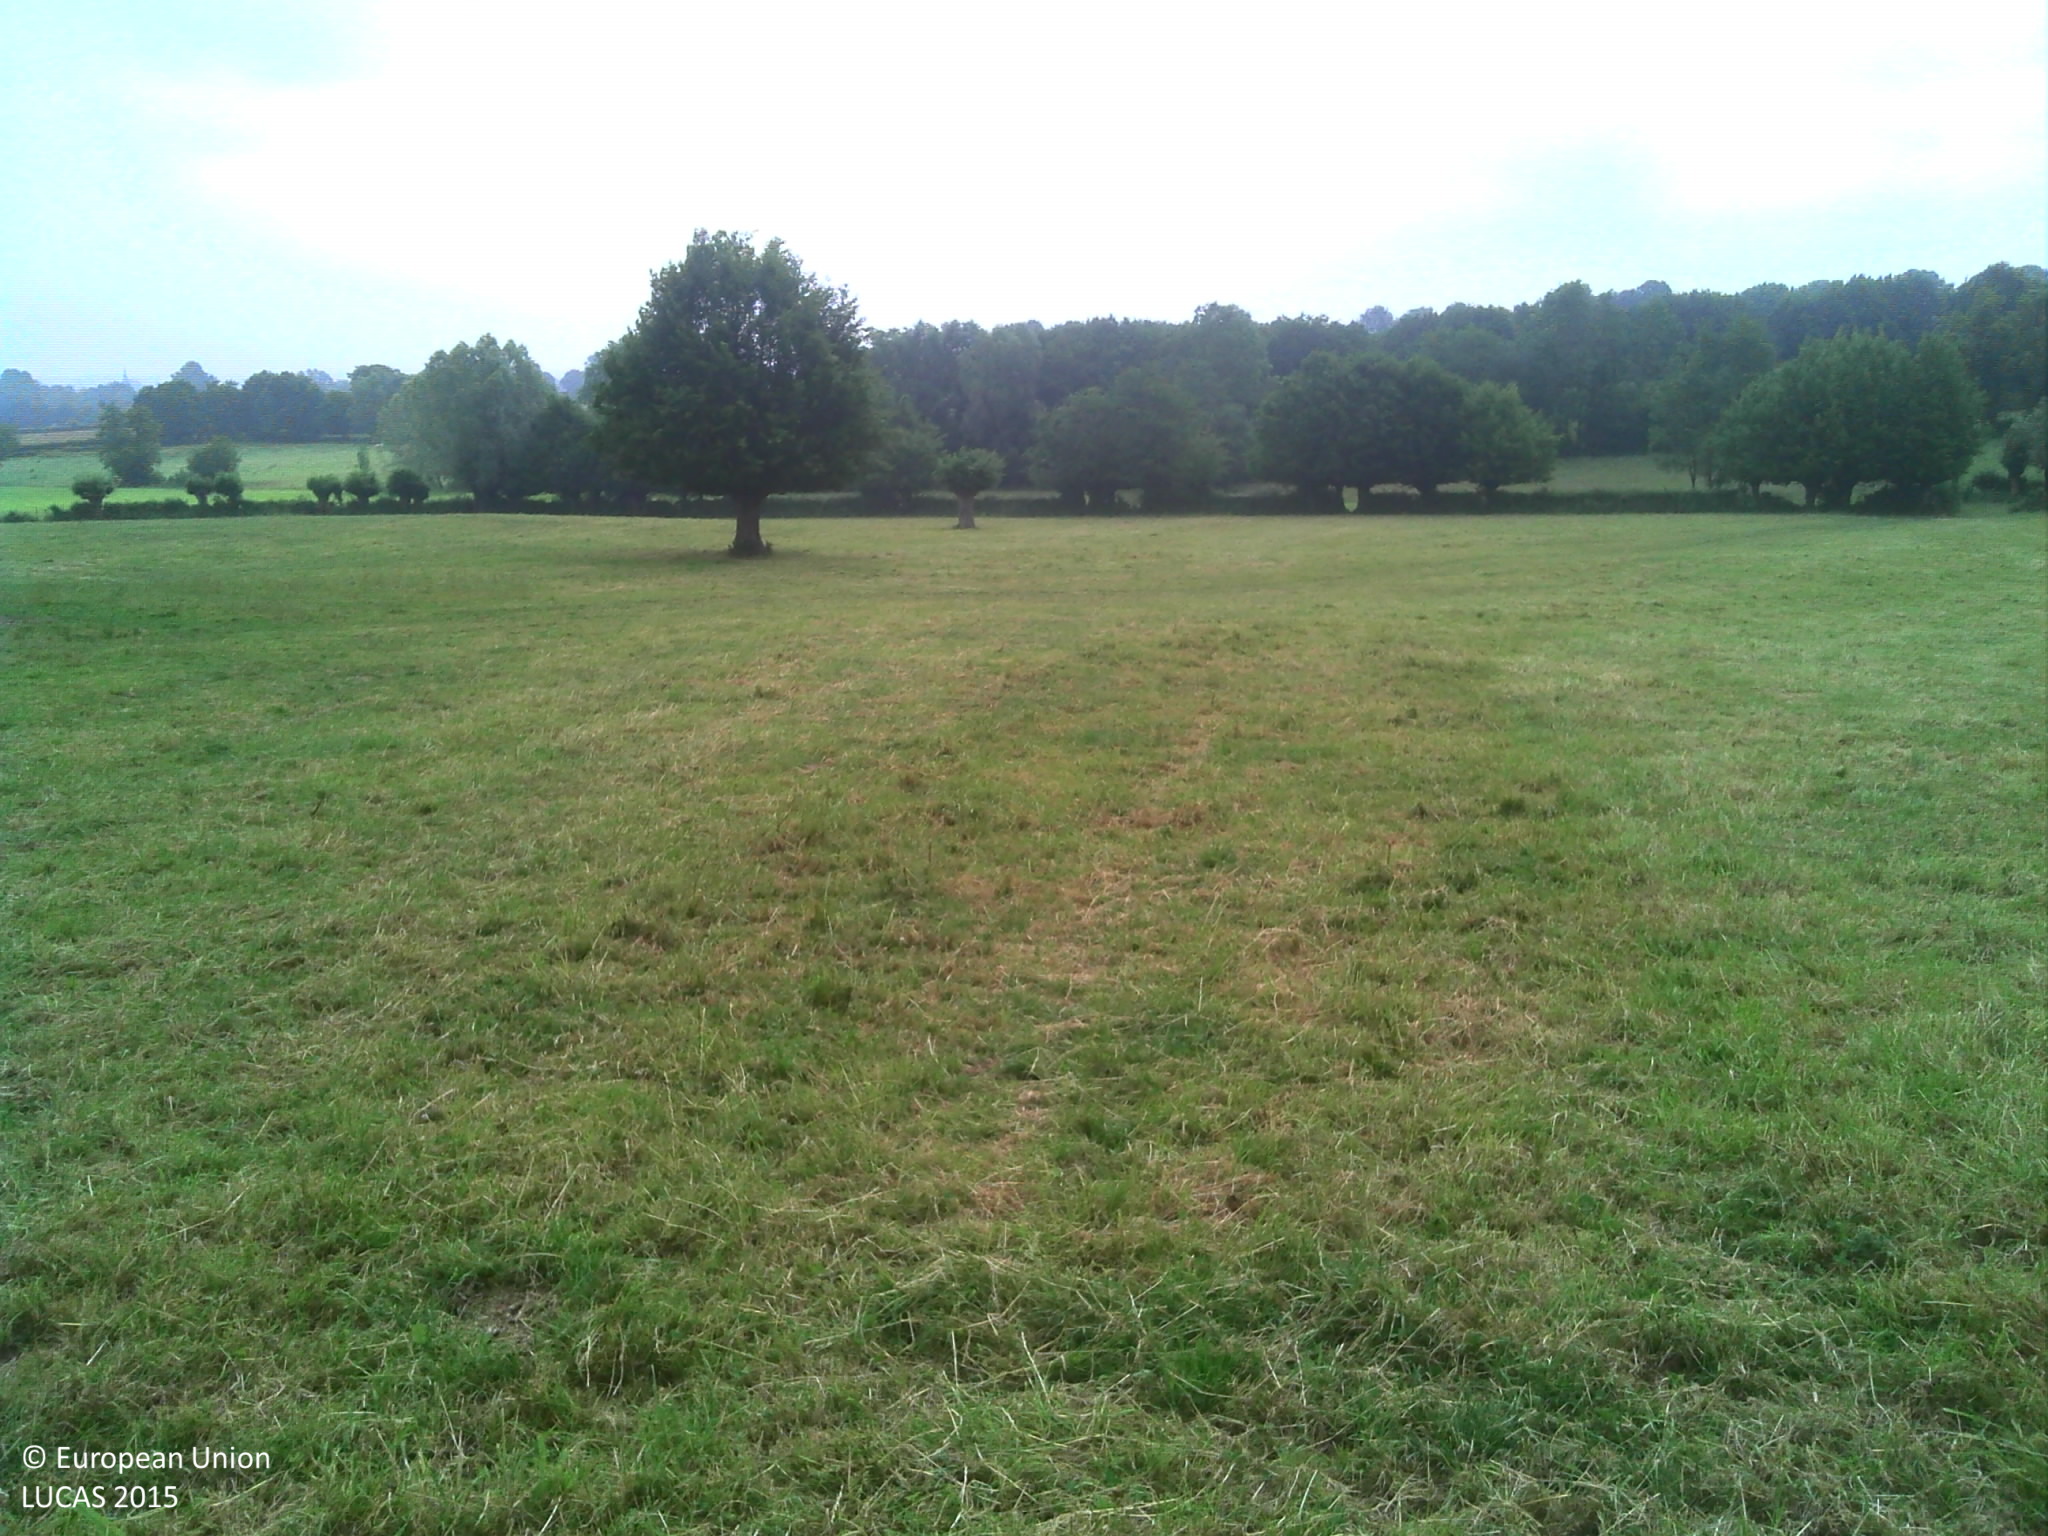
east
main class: Grassland
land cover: Grassland without tree/shrub cover
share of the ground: > 75 %
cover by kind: herbaceous plants 100 %
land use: Agriculture (excluding fallow land and kitchen gardens)
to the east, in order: Grassland without tree/shrub cover; Abandoned hedges; Fences; Grassland without tree/shrub cover; Ditches and canals; Grassland without tree/shrub cover; Broadleaved woodland; Fences; Grassland without tree/shrub cover
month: June
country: FR
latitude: 50.0072
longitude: 3.9805
